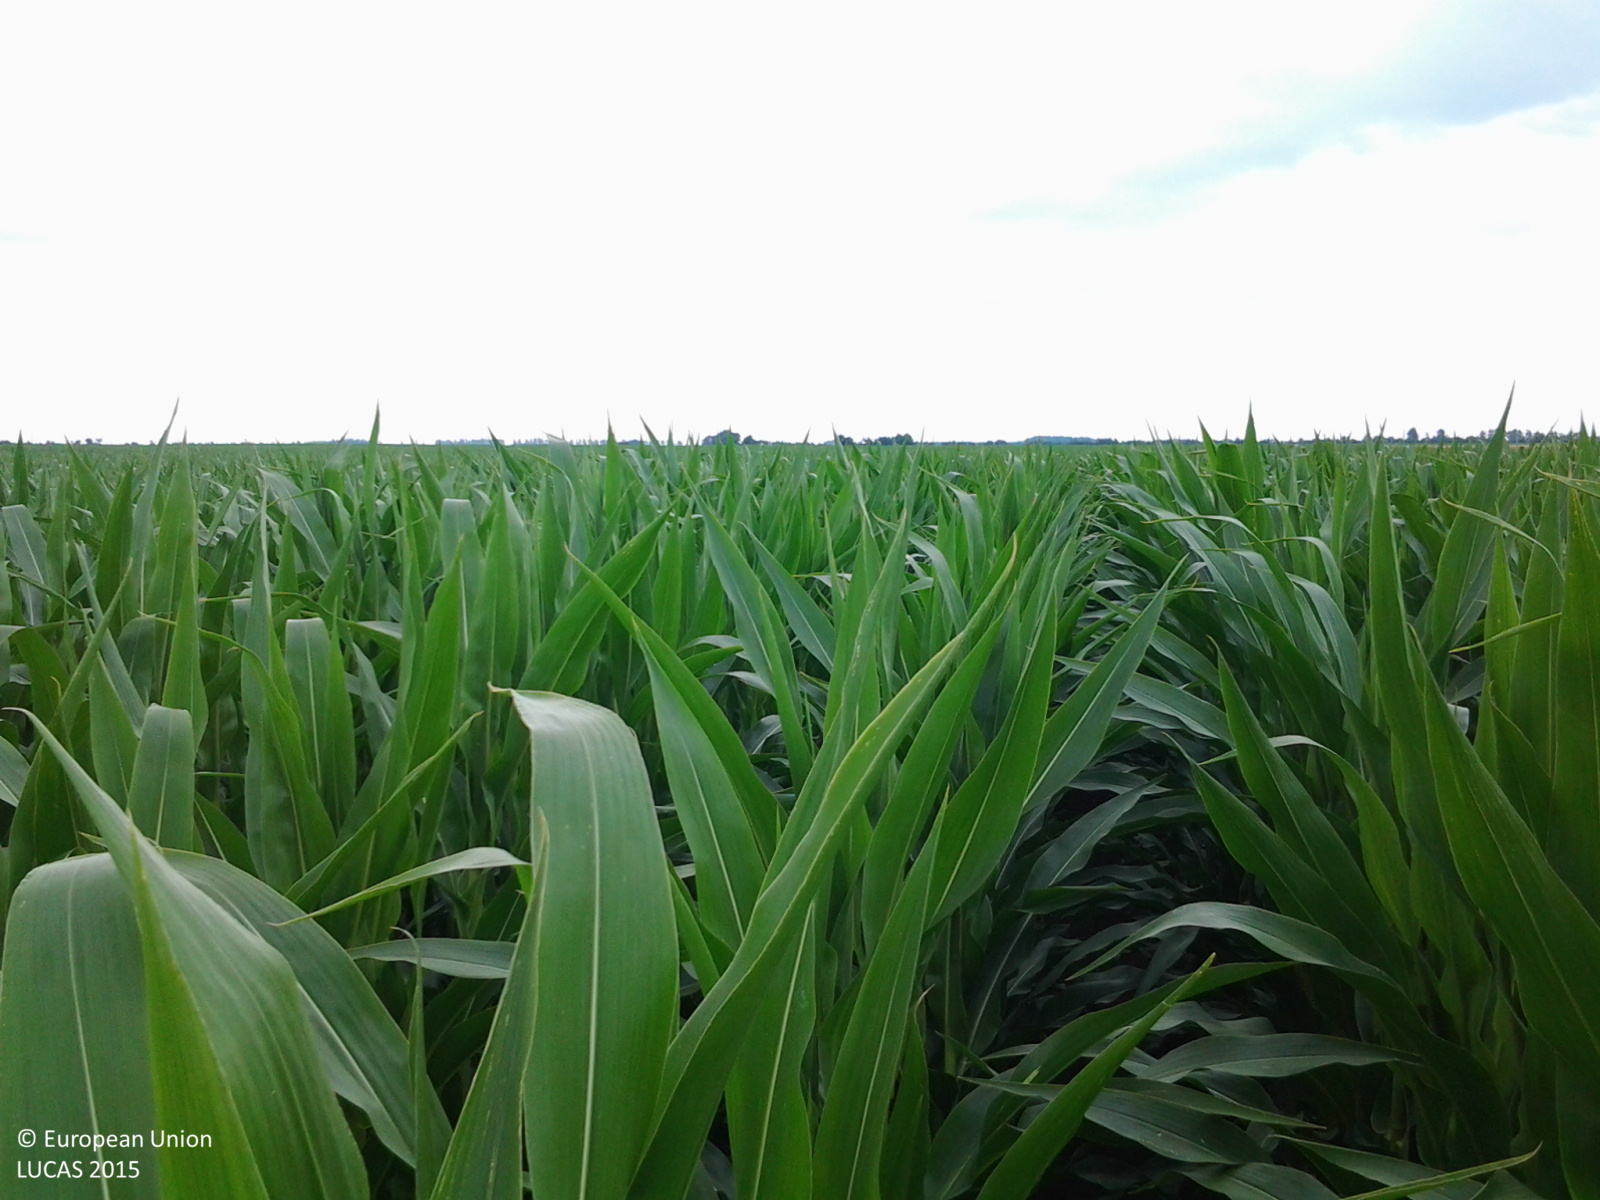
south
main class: Cropland
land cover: Maize
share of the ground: > 75 %
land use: Agriculture (excluding fallow land and kitchen gardens)
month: June
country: HU
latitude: 46.4020
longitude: 21.1541
